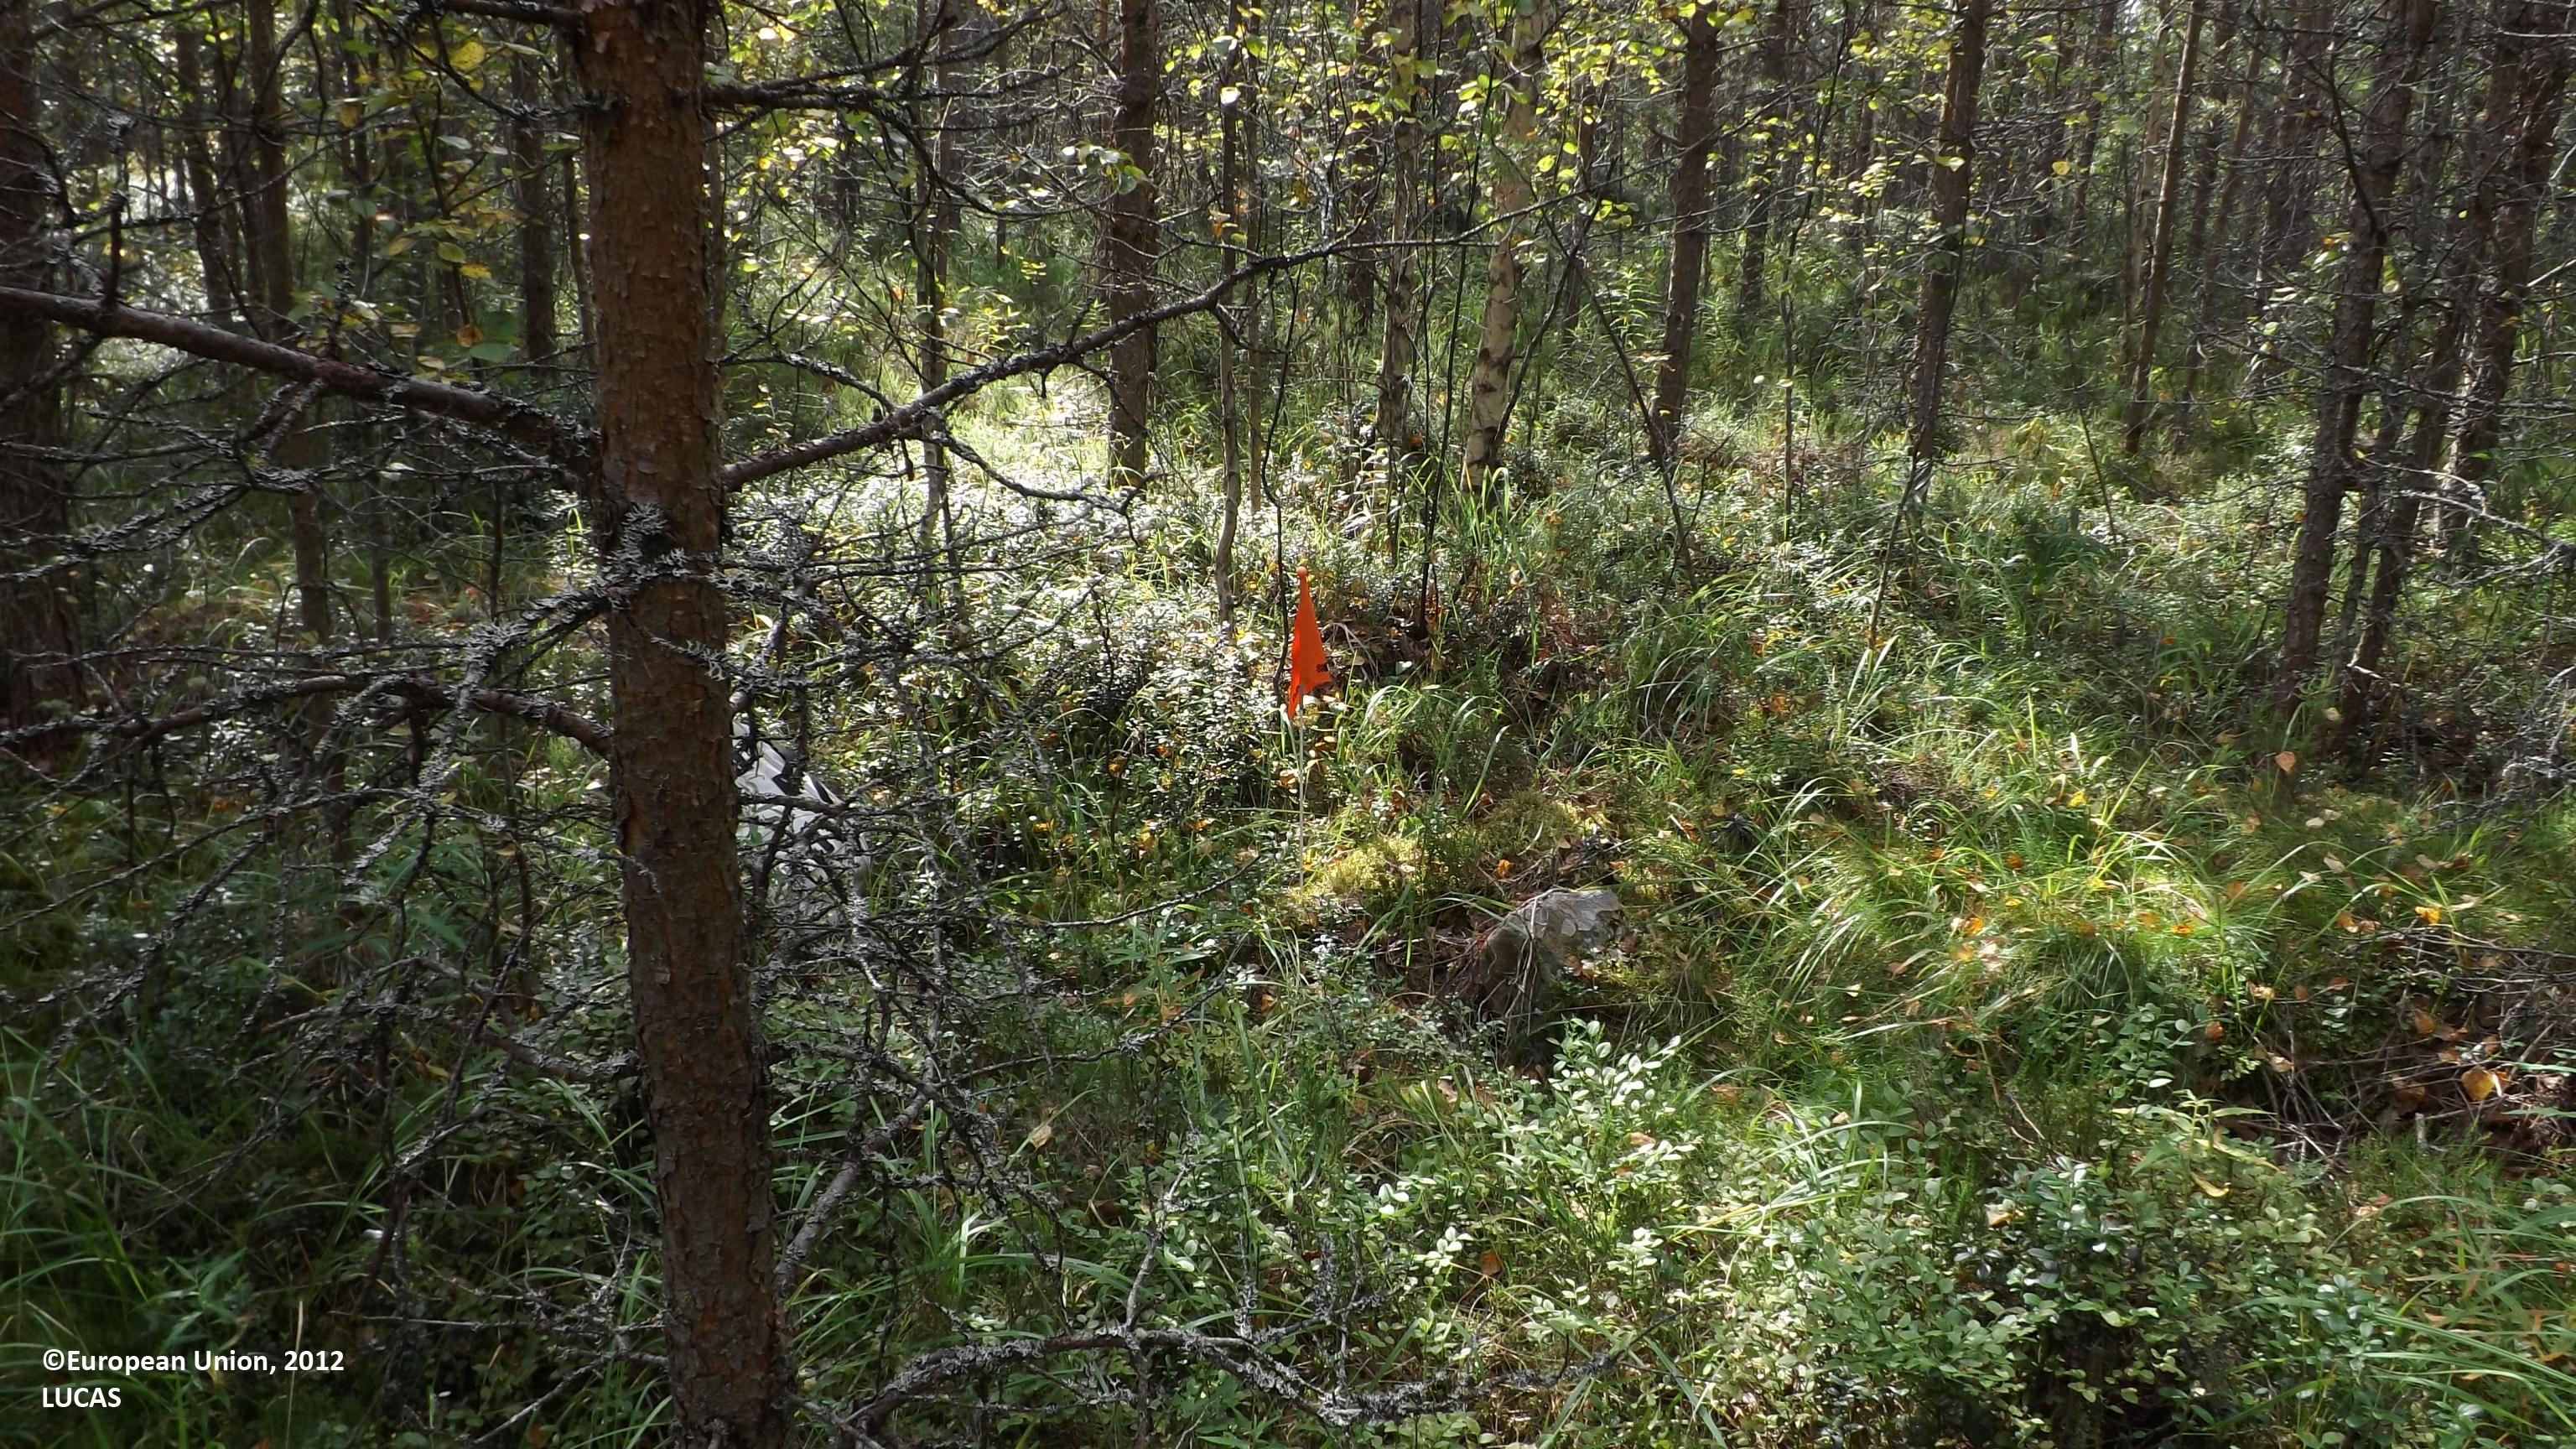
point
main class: Woodland
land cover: Pine dominated mixed woodland
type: boreal forest
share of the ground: > 75 %
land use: Forestry
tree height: > 5 m
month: August
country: FI
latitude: 63.0995
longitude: 24.3247
